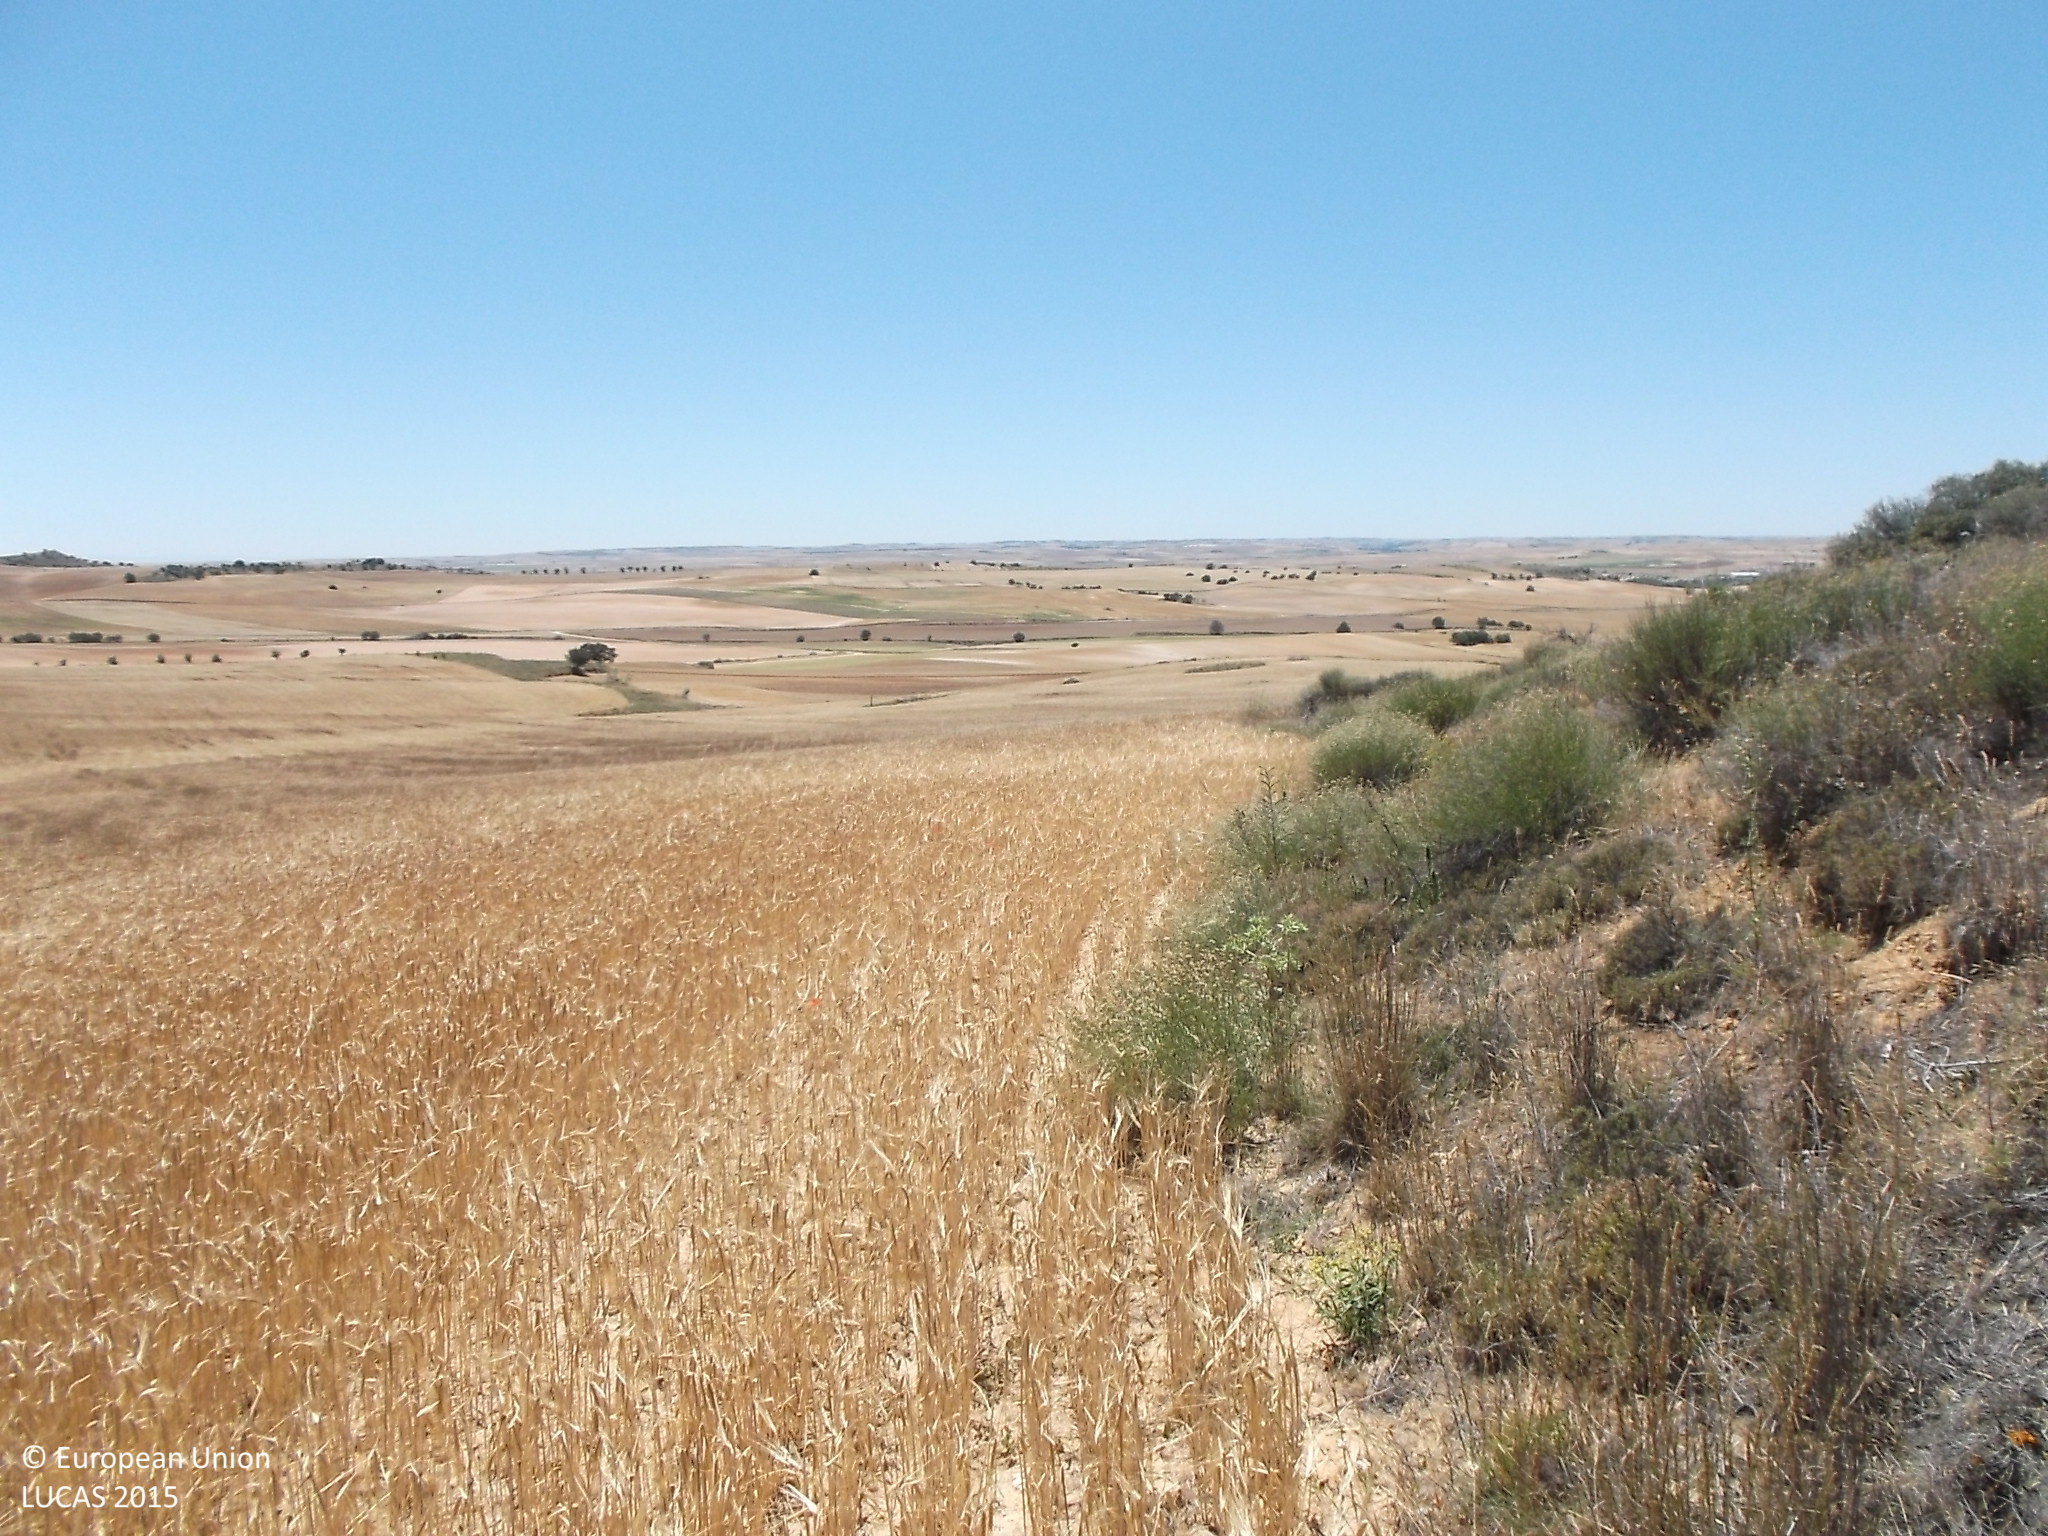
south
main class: Cropland
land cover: Barley
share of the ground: > 75 %
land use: Agriculture (excluding fallow land and kitchen gardens)
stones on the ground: < 10 %
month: June
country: ES
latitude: 41.3632
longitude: -5.3666
